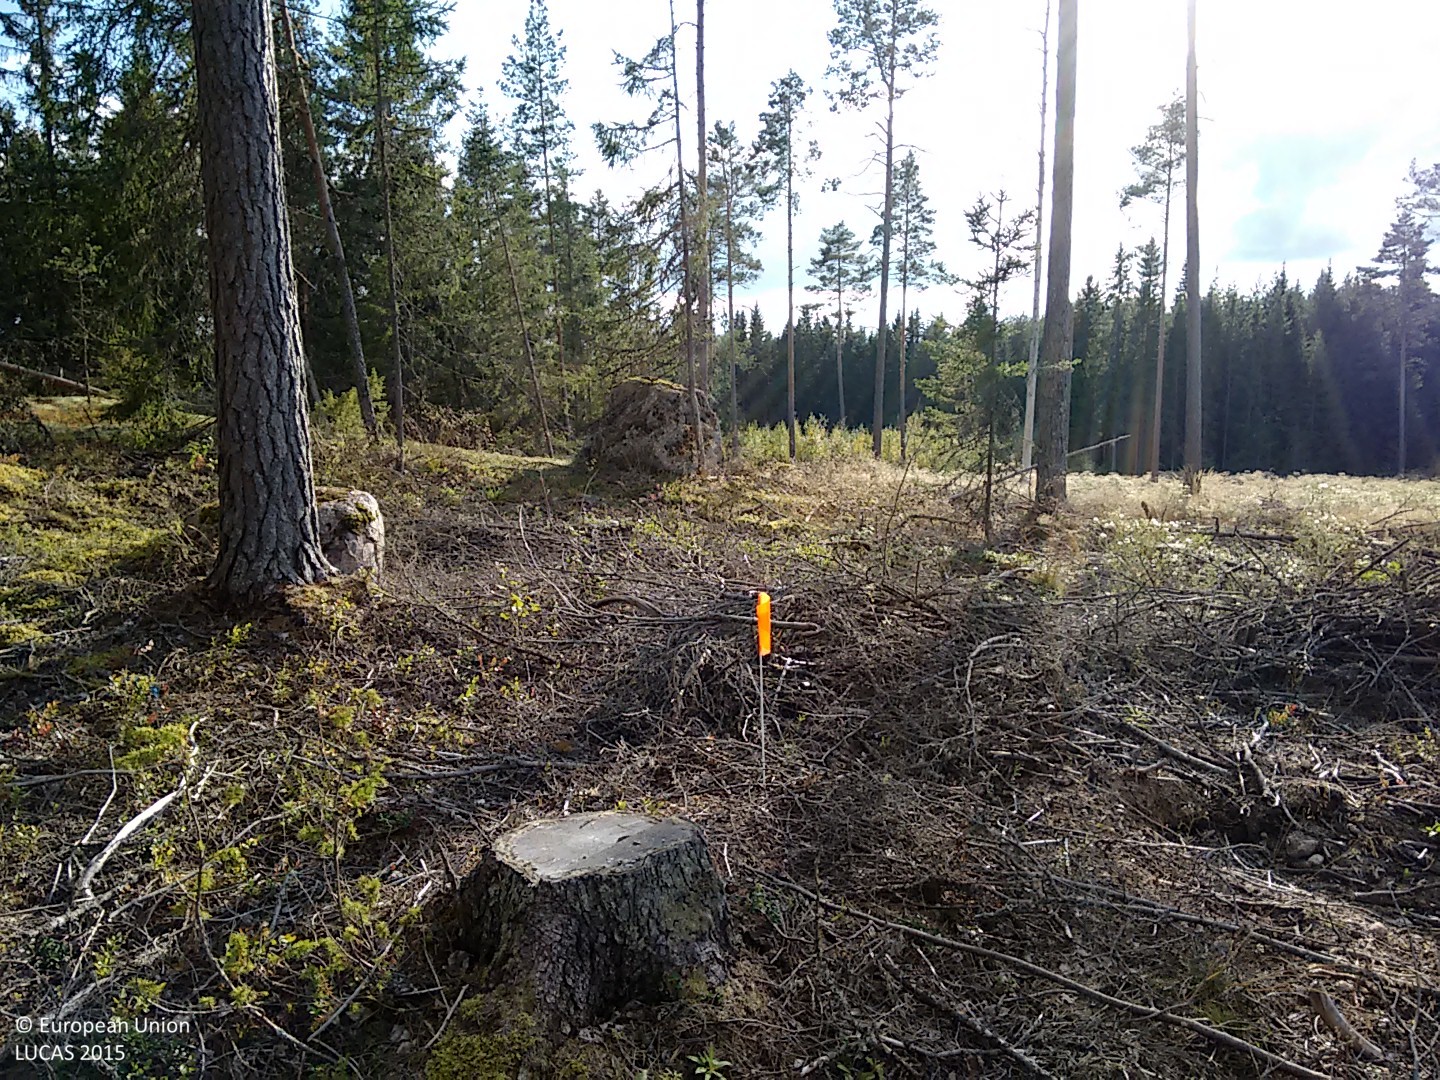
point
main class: Woodland
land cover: Pine dominated coniferous woodland
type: hemiboreal forest and nemoral coniferous forest and mixed broadleaved-coniferous forest
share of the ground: 10 - 25 %
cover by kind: herbaceous plants 65 %, coniferous forest trees 20 %, shrubs 15 %
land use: Forestry
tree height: < 5 m
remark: Clear cut
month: September
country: FI
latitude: 60.9288
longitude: 21.7356
